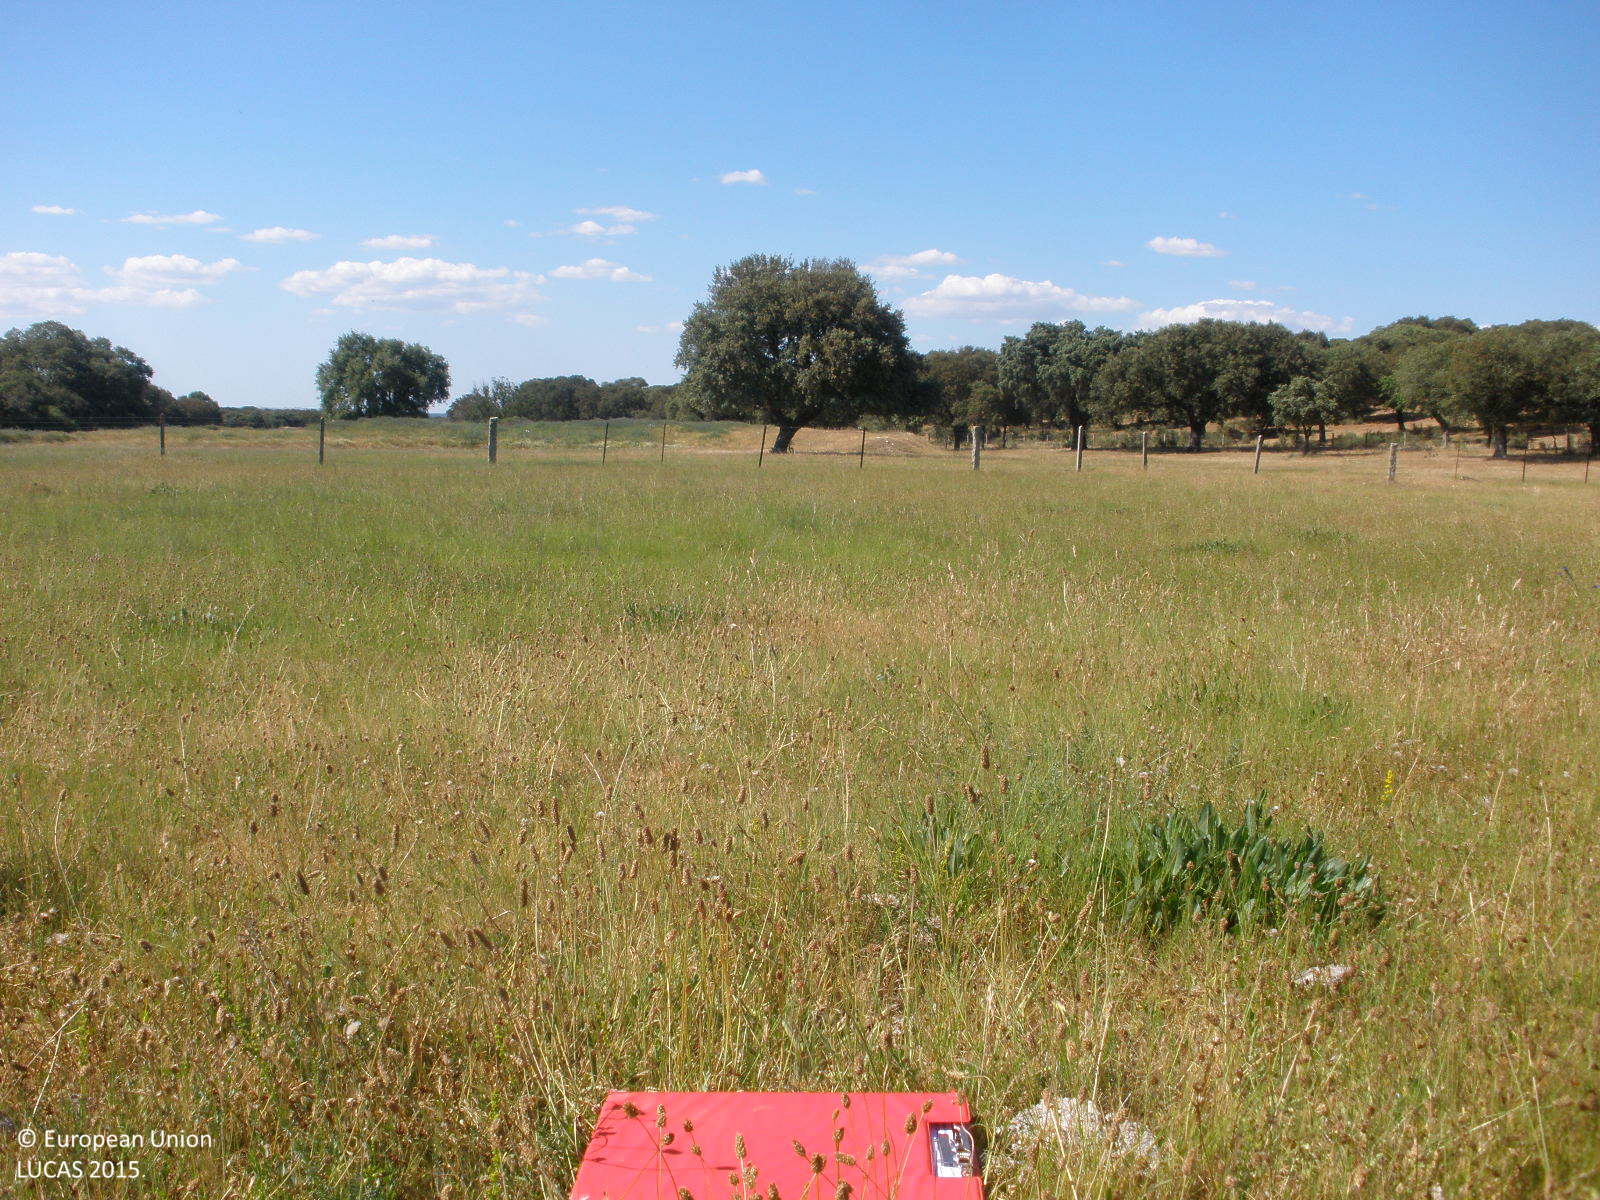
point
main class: Grassland
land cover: Grassland without tree/shrub cover
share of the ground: > 75 %
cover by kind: herbaceous plants 100 %
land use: Agriculture (excluding fallow land and kitchen gardens)
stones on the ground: < 10 %
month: June
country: ES
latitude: 40.4884
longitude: -6.6669
